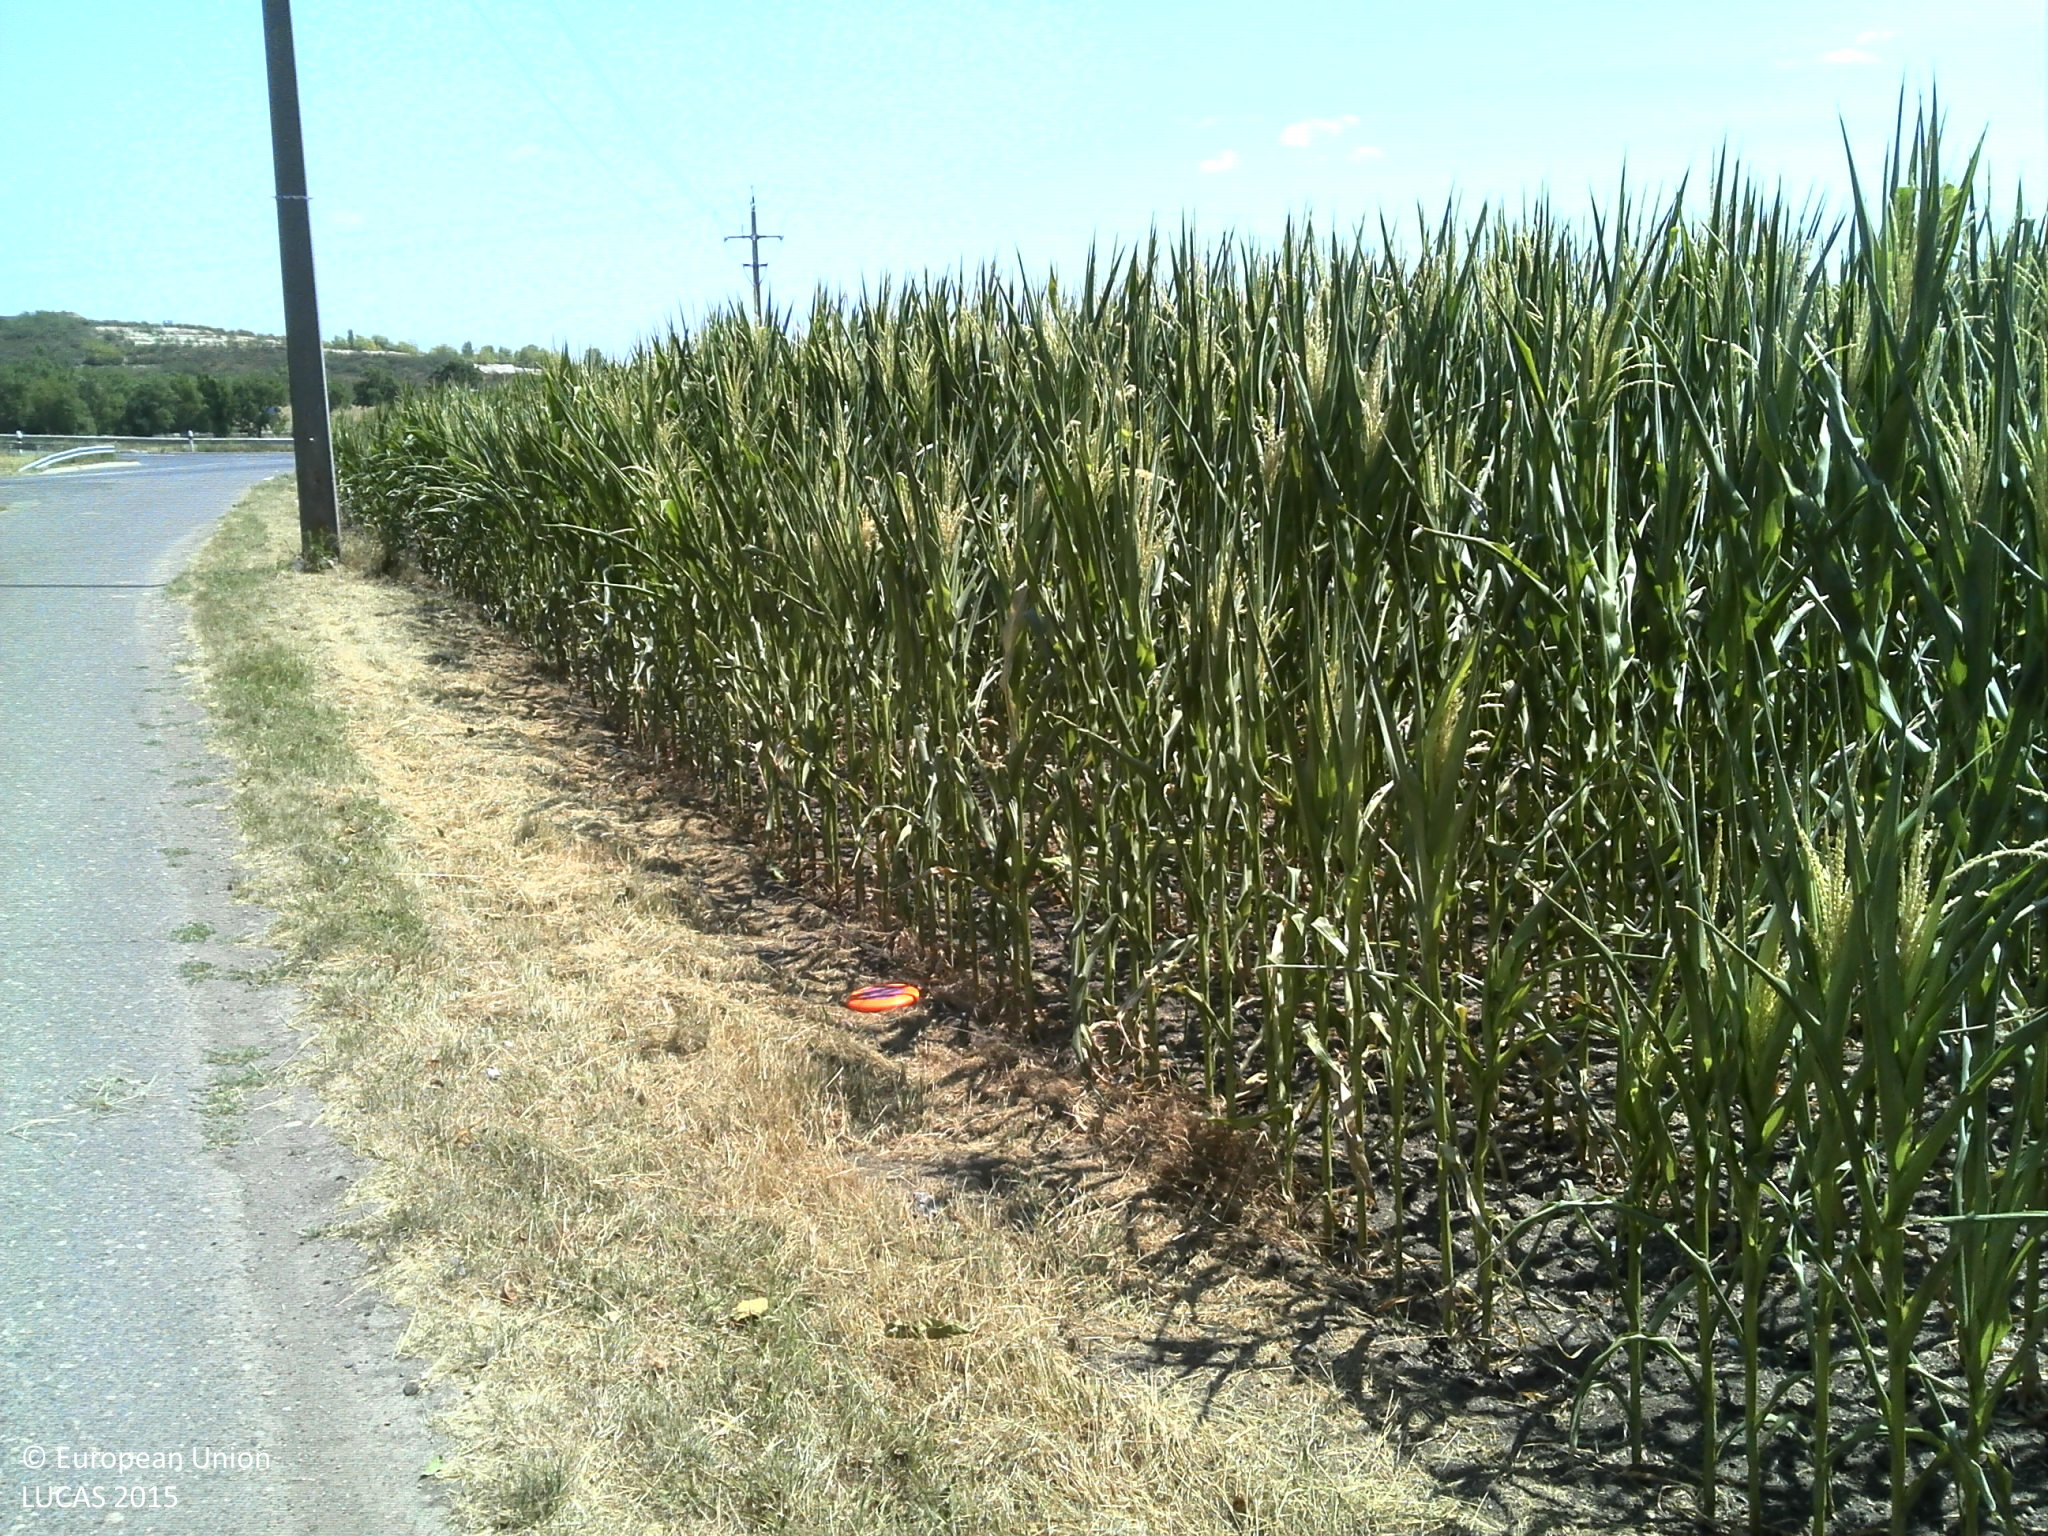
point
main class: Cropland
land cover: Maize
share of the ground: > 75 %
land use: Agriculture (excluding fallow land and kitchen gardens)
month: July
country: FR
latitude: 45.7697
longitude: 3.1460
